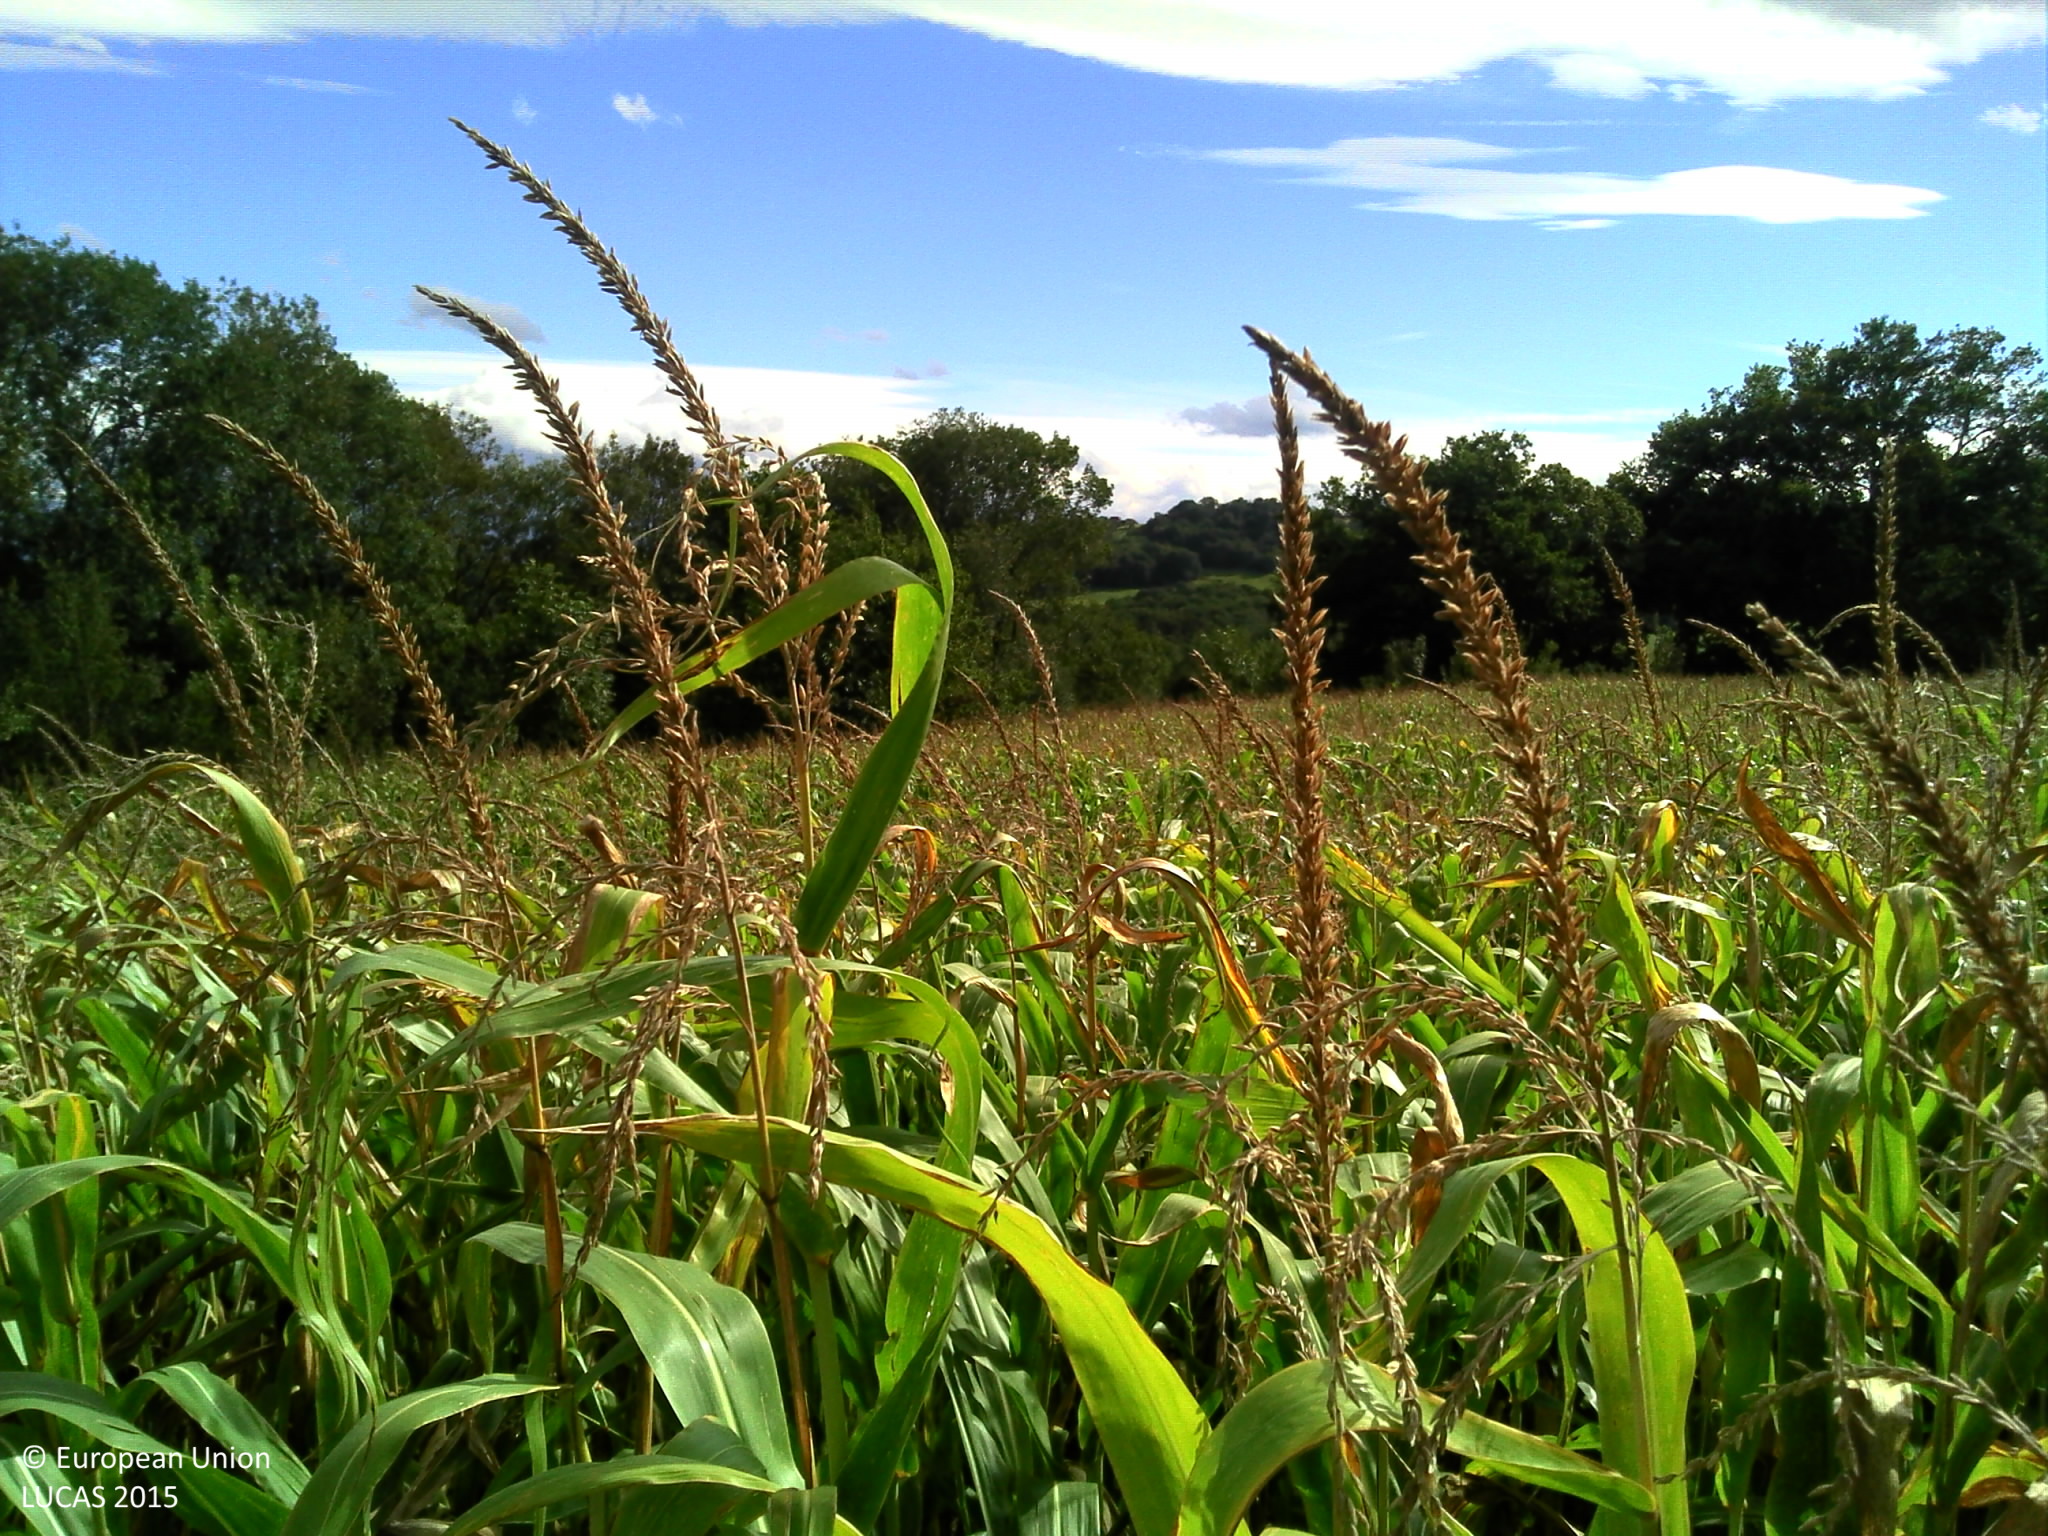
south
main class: Cropland
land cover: Maize
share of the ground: > 75 %
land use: Agriculture (excluding fallow land and kitchen gardens)
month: September
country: FR
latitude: 43.3993
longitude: -0.6654
